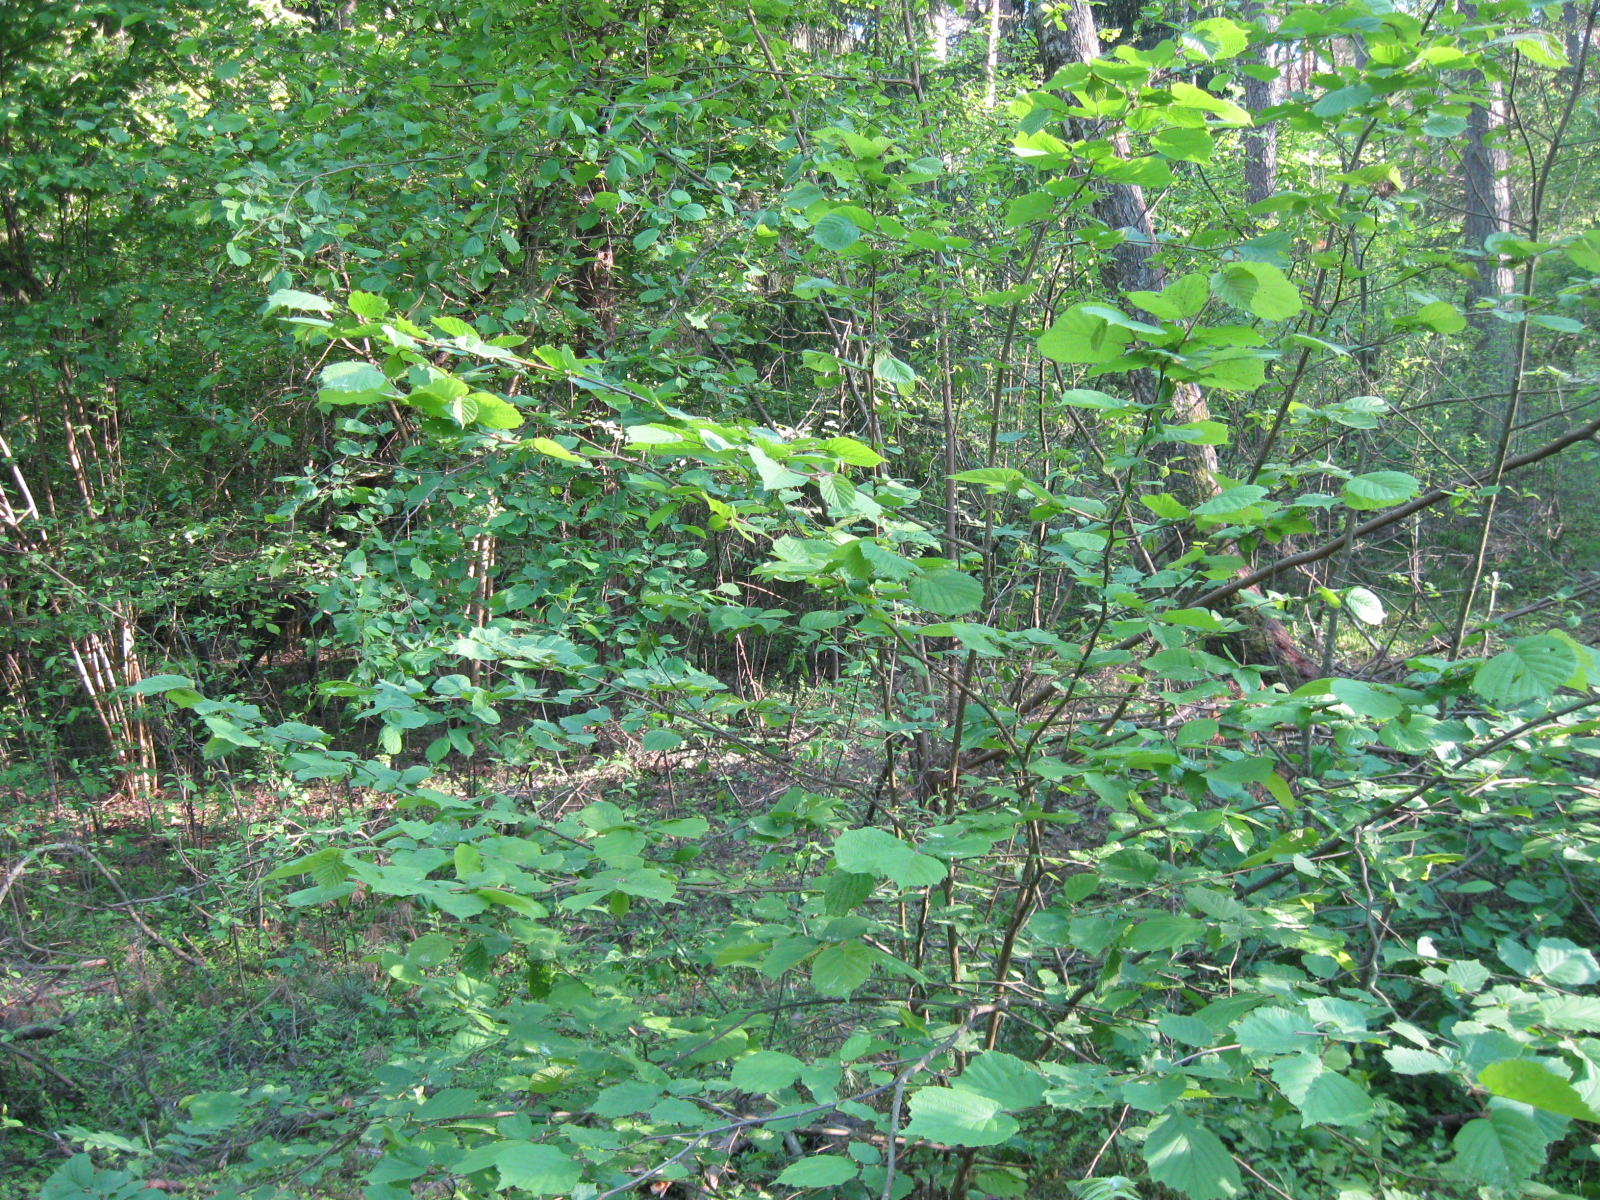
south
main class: Woodland
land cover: Pine dominated mixed woodland
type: hemiboreal forest and nemoral coniferous forest and mixed broadleaved-coniferous forest
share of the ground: > 75 %
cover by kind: coniferous forest trees 60 %, broadleaved forest trees 30 %, herbaceous plants 10 %
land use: Forestry
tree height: > 5 m
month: June
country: LT
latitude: 54.1308
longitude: 23.7227
